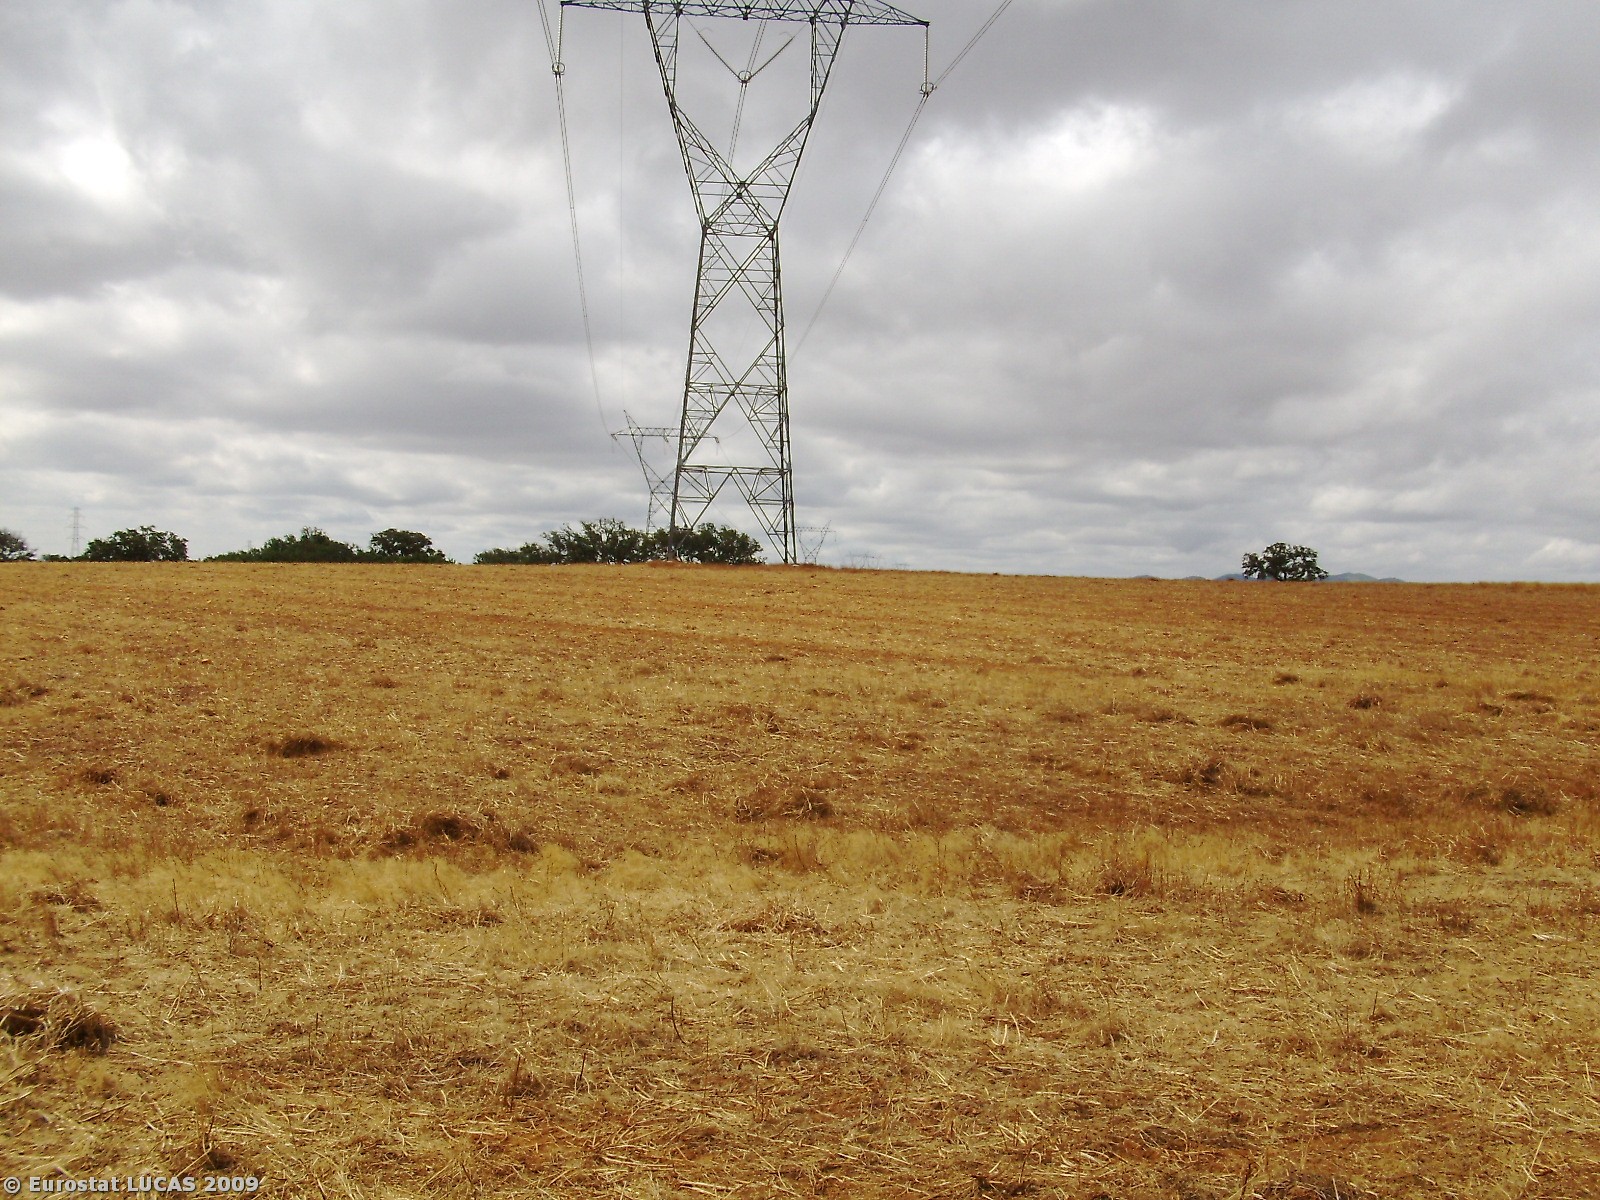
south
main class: Grassland
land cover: Spontaneously vegetated surfaces
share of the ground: > 75 %
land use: Fallow land
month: June
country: PT
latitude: 37.8634
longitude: -8.6750
